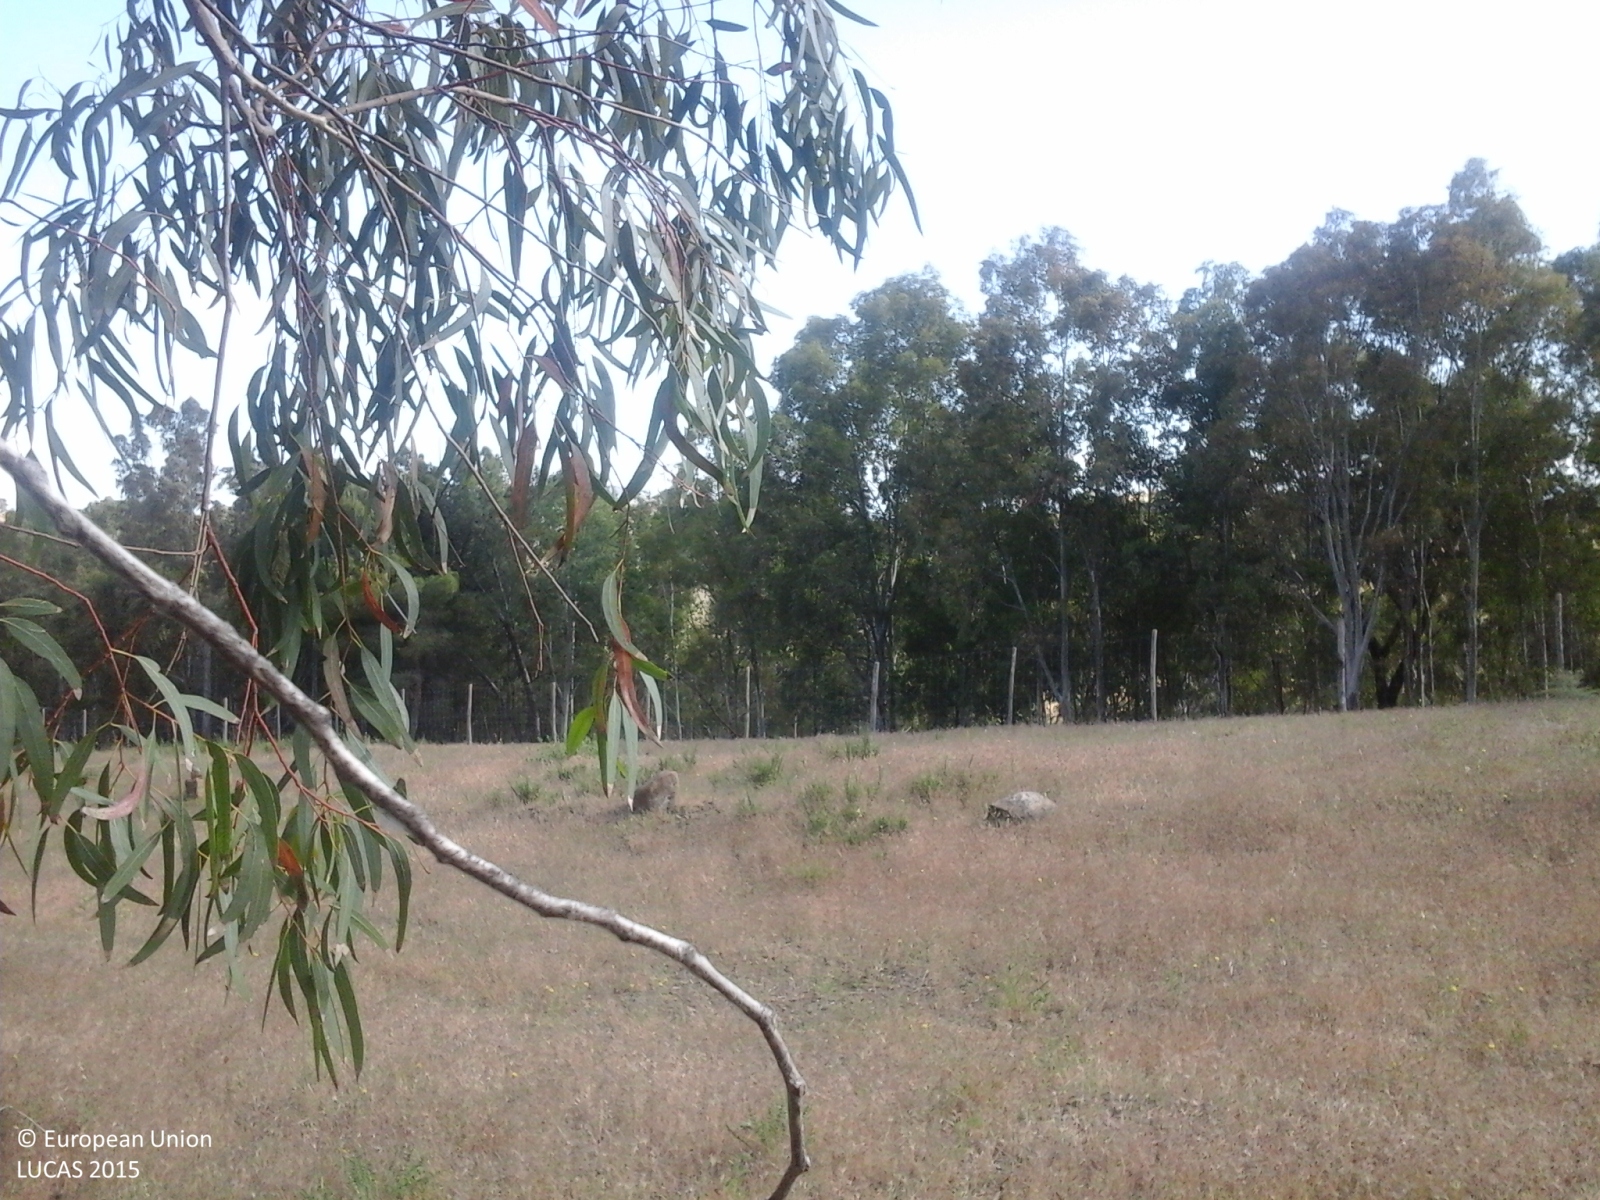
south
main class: Woodland
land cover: Broadleaved woodland
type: exotic forest
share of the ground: > 75 %
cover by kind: broadleaved forest trees 100 %
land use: Forestry
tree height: > 5 m
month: May
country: IT
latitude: 37.5672
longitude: 14.1246
